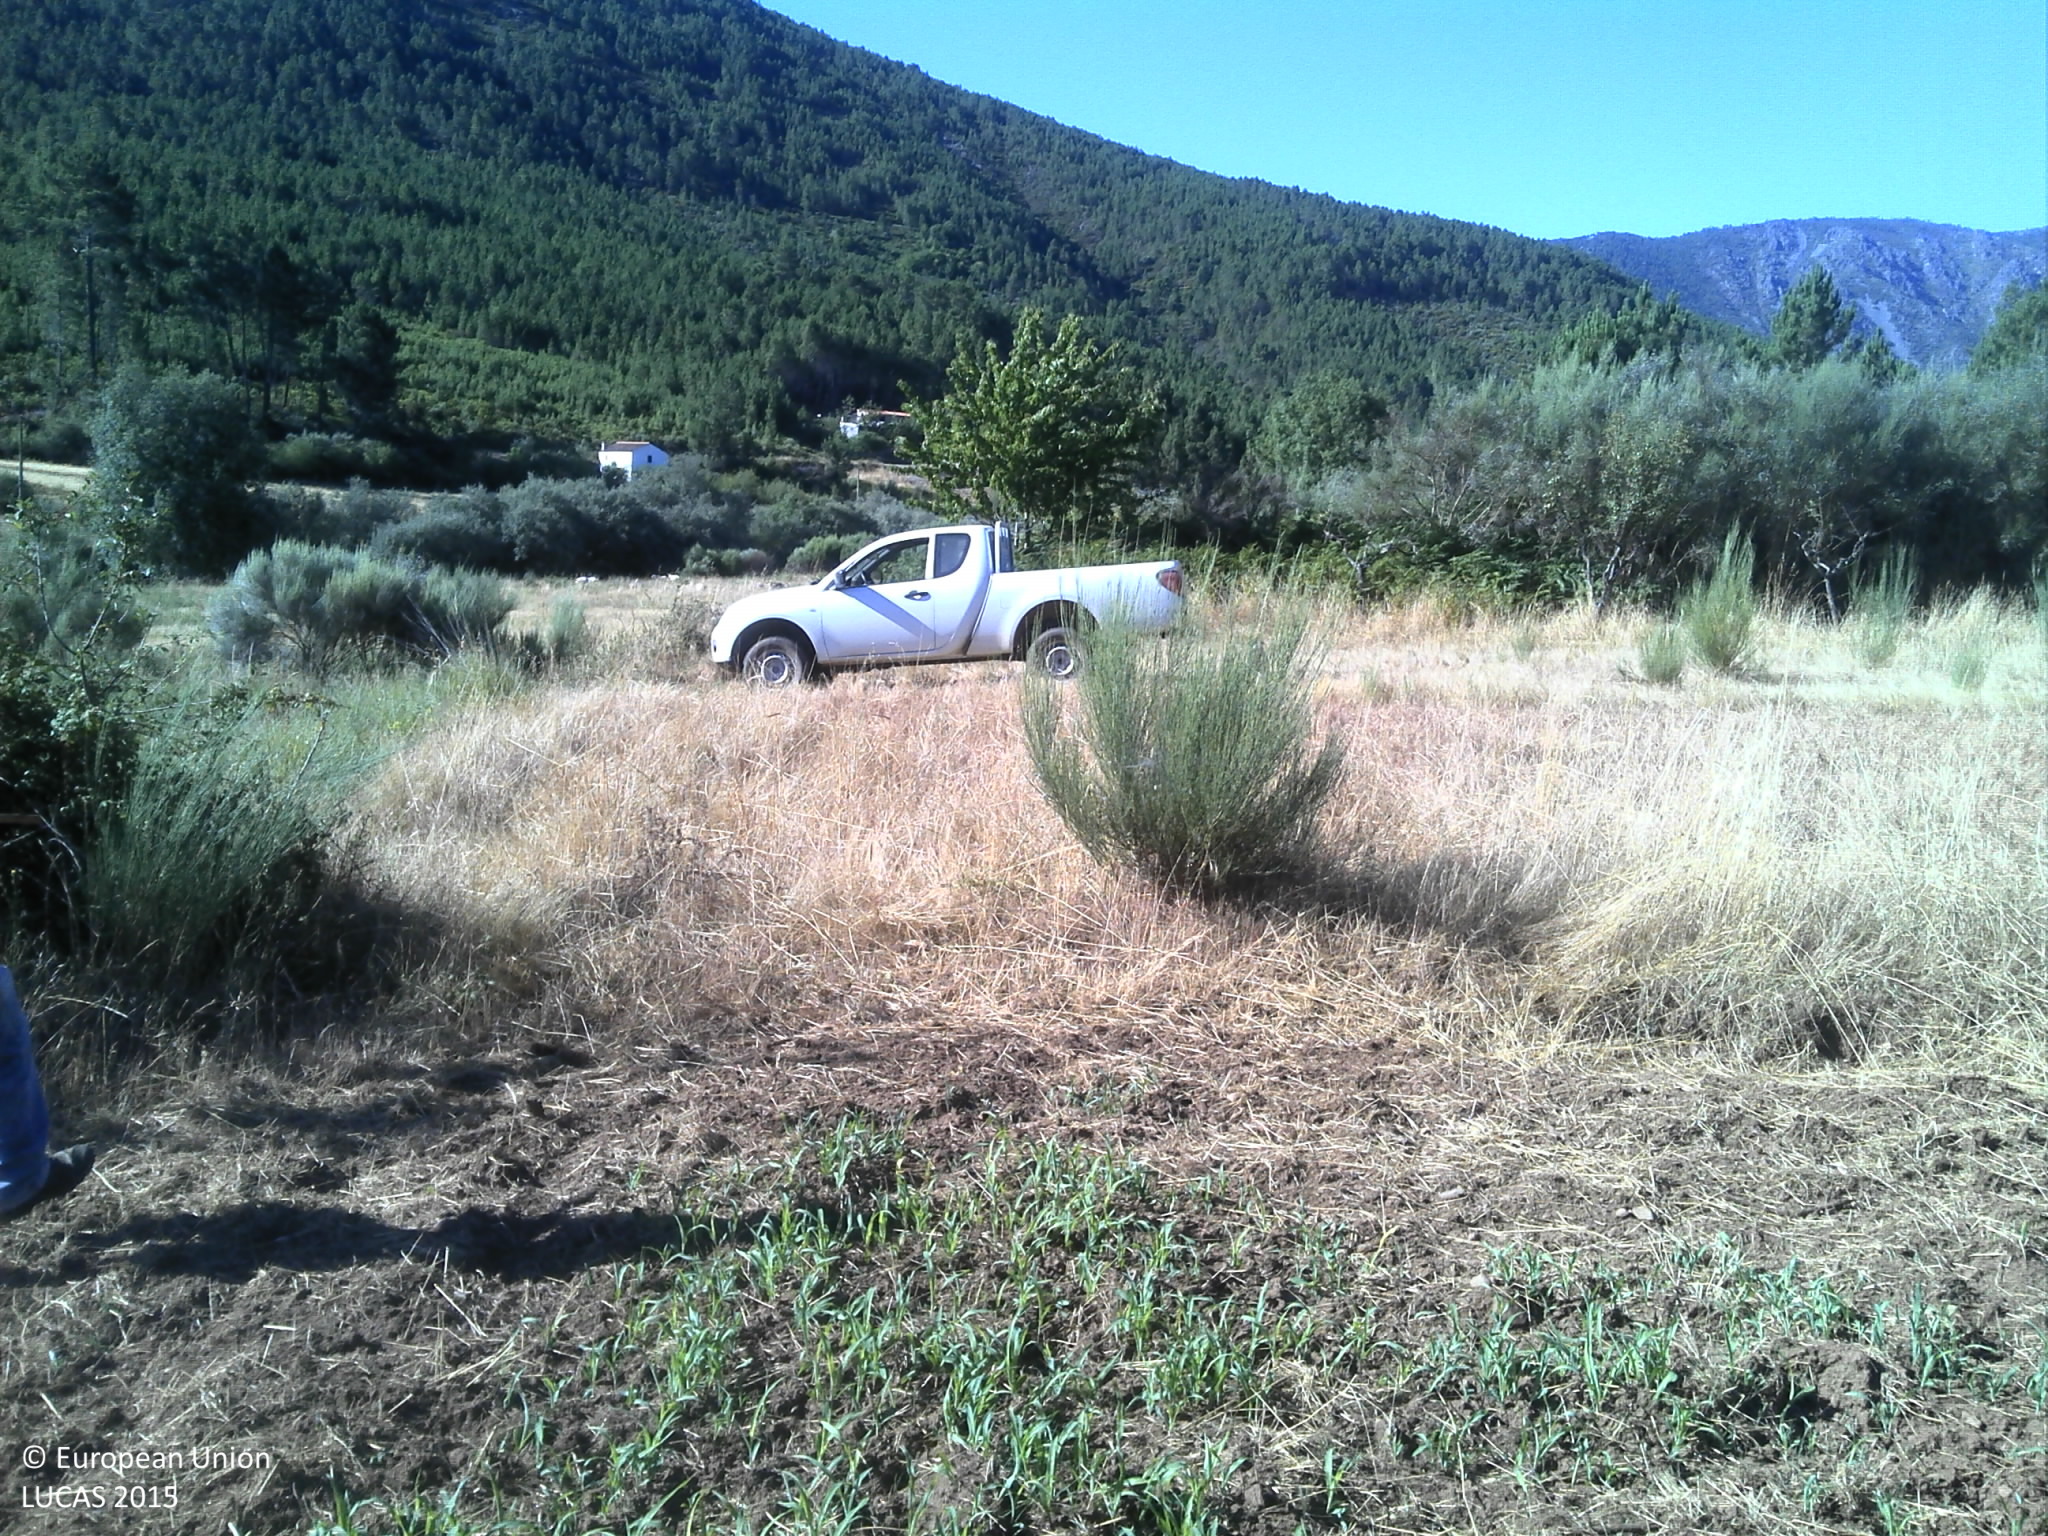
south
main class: Grassland
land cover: Spontaneously vegetated surfaces
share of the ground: 10 - 25 %
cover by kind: unconsolidated bare surface 80 %, herbaceous plants 20 %
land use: Fallow land
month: July
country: PT
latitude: 40.3642
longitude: -7.4778
